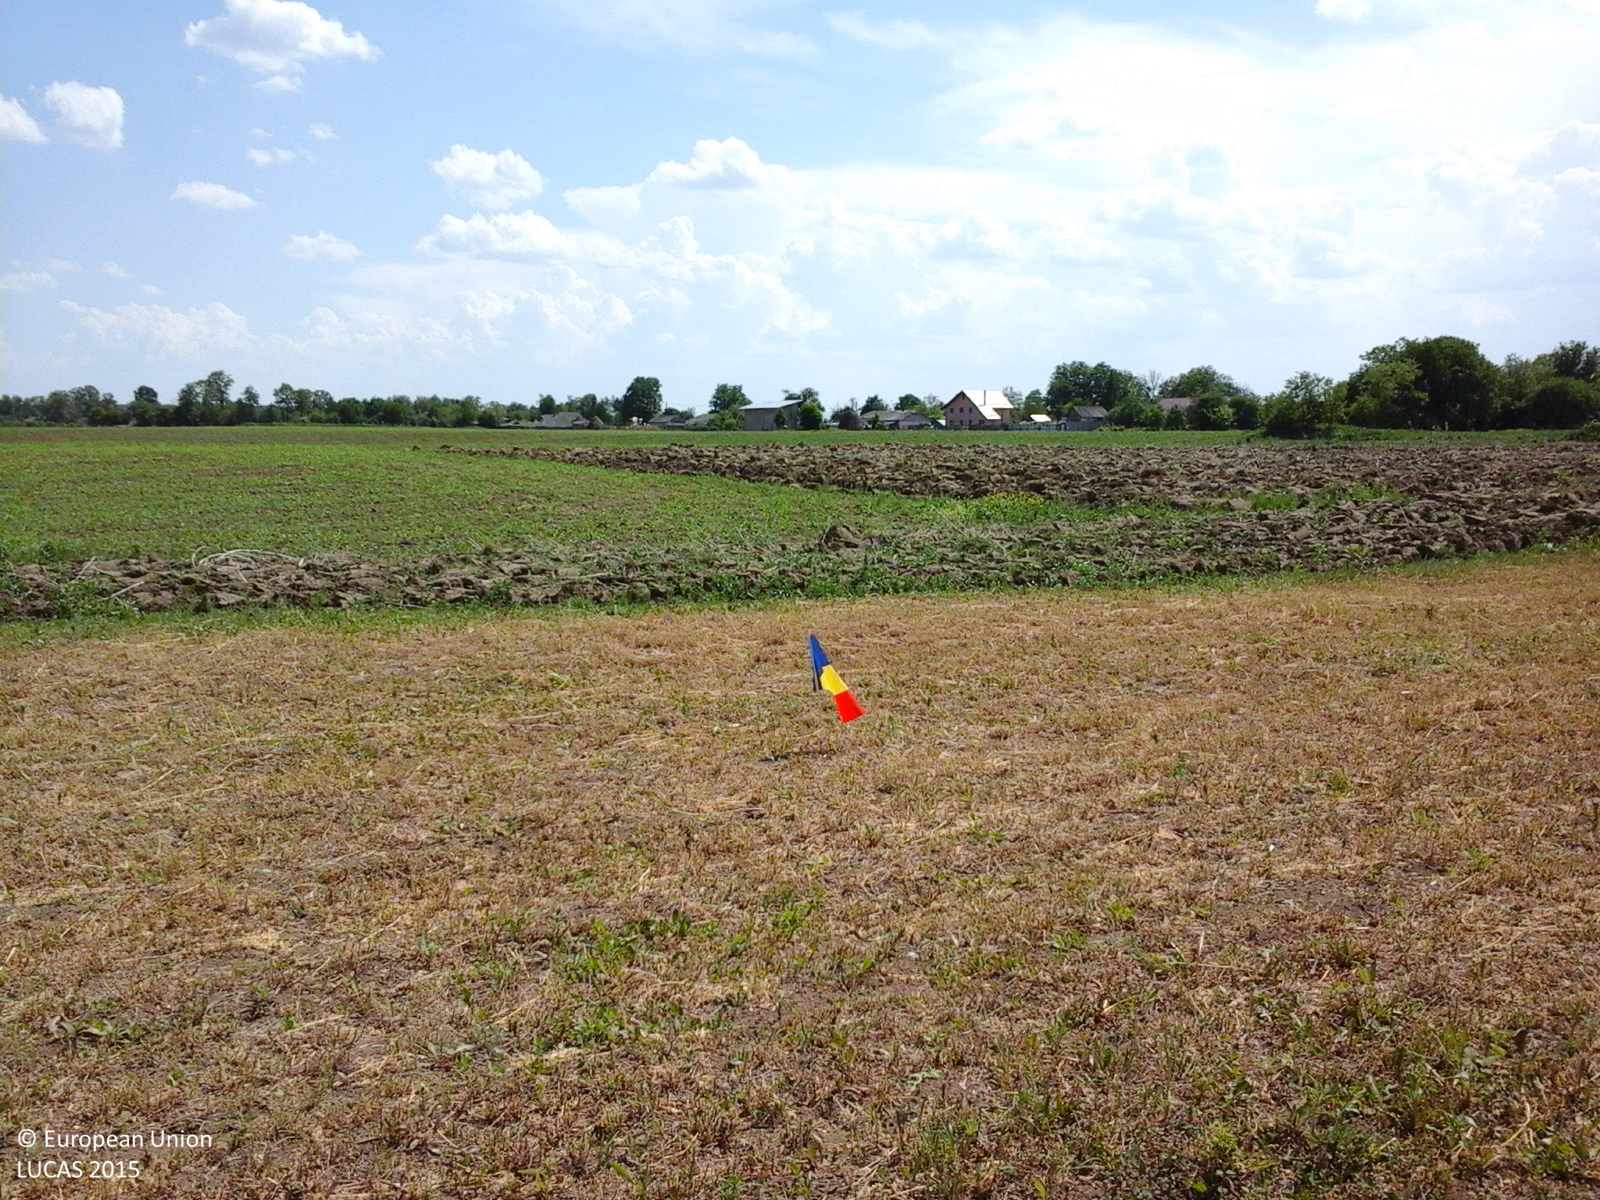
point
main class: Cropland
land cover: Lucerne
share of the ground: 10 - 25 %
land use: Agriculture (excluding fallow land and kitchen gardens)
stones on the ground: < 10 %
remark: Harvested field
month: June
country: RO
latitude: 46.7735
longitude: 26.9241
